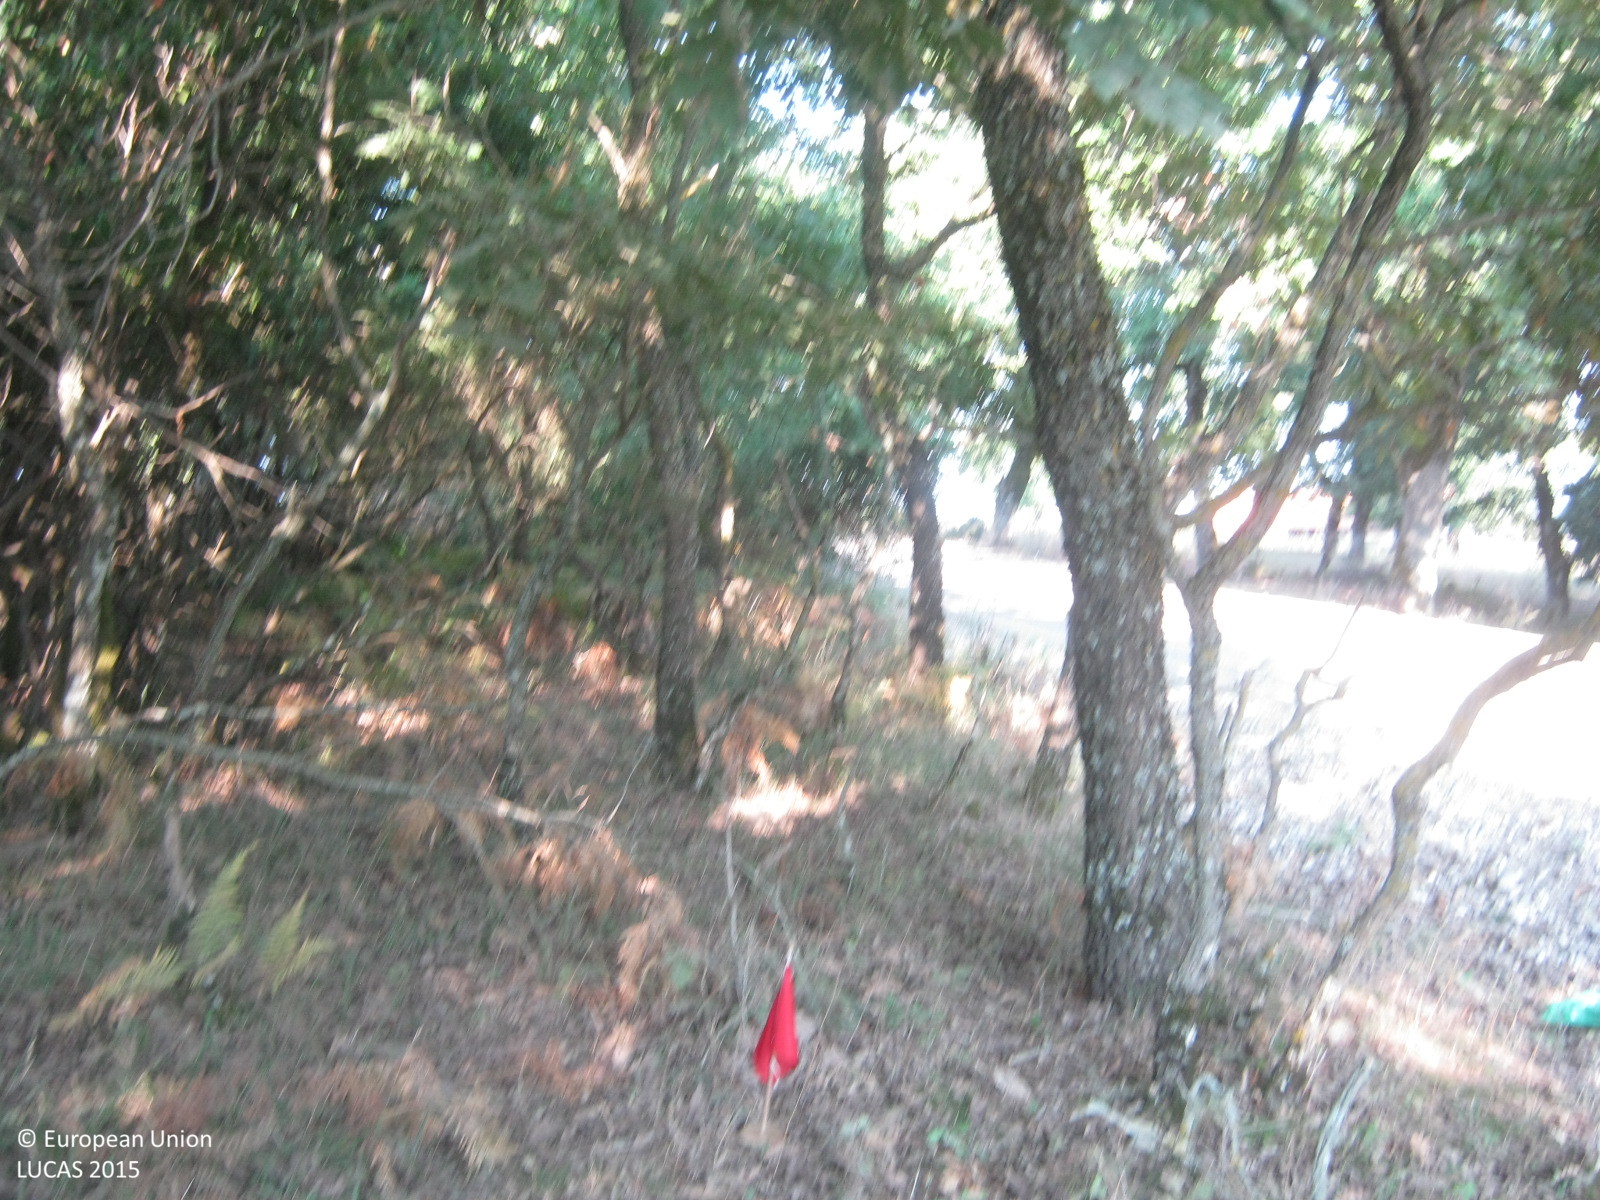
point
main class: Woodland
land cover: Broadleaved woodland
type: broadleaved evergreen forest
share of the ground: > 75 %
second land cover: Spontaneously vegetated surfaces
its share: 10 - 25 %
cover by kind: broadleaved forest trees 90 %, herbaceous plants 5 %, consolidated bare surface 5 %
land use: Forestry
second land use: Agriculture (excluding fallow land and kitchen gardens)
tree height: > 5 m
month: September
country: GR
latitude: 37.7869
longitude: 21.7369
